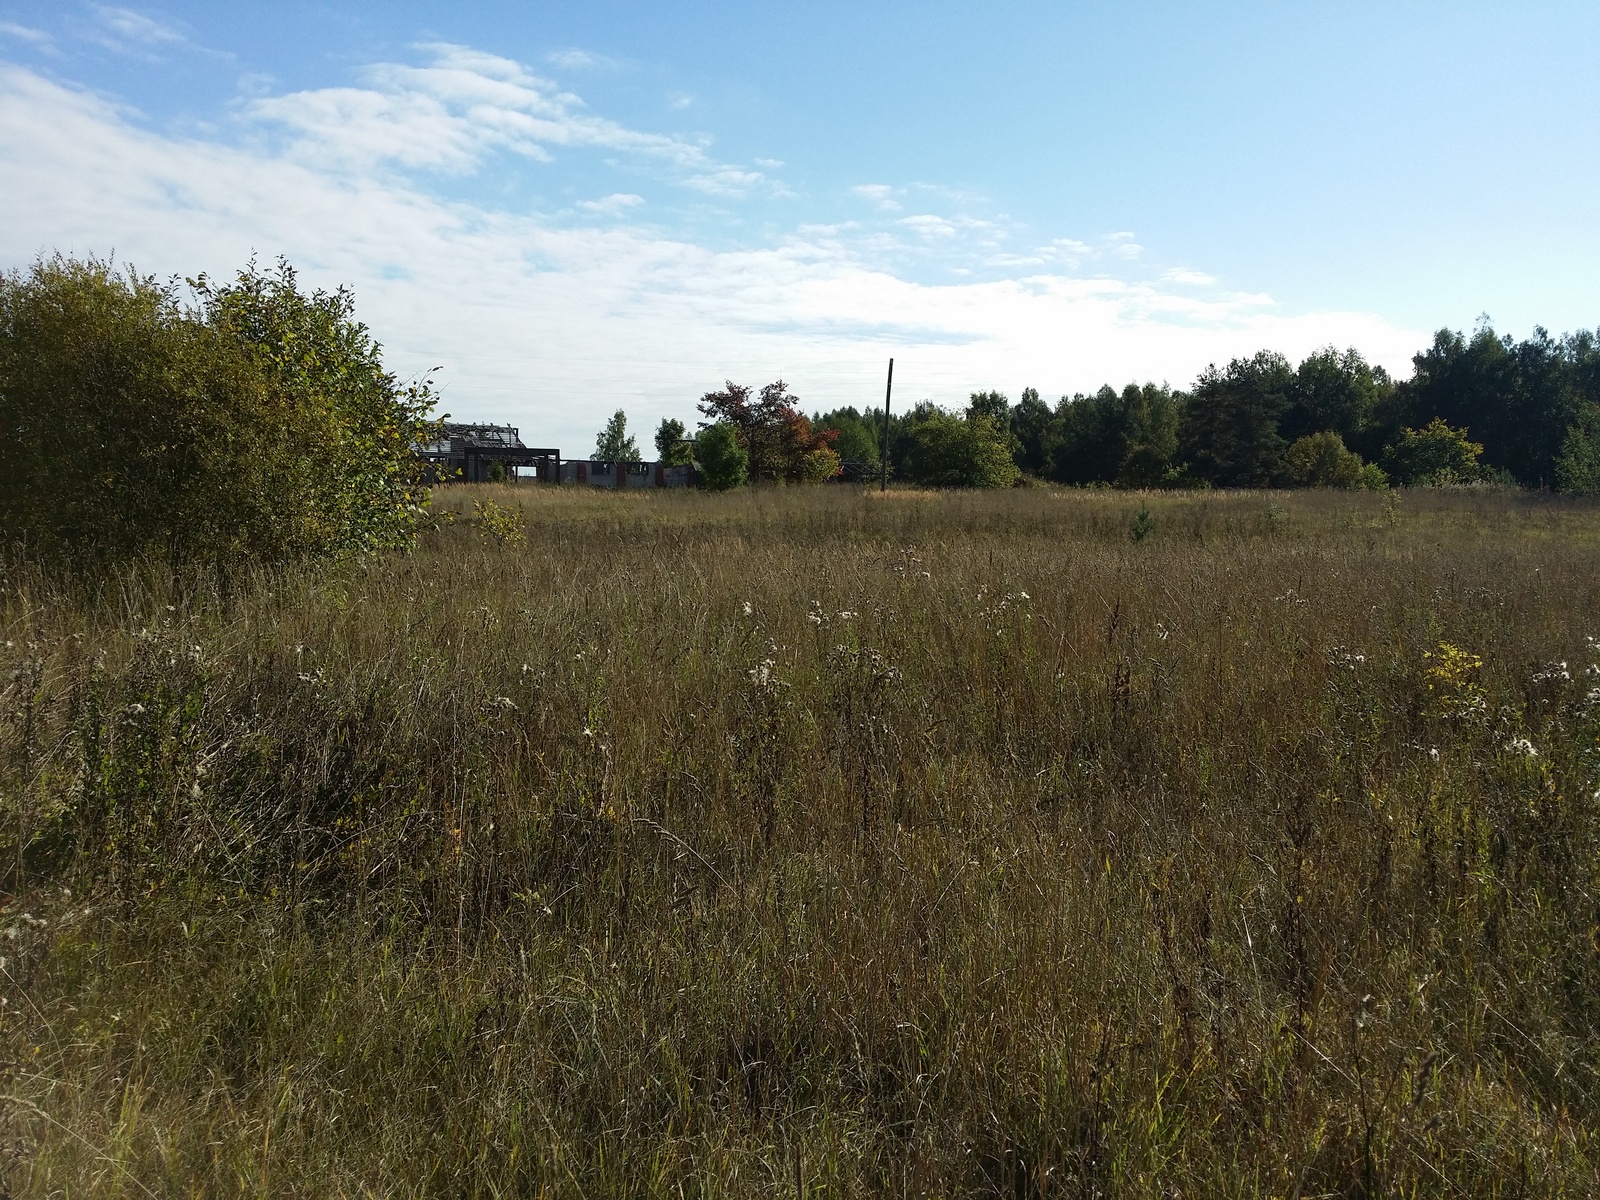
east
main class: Grassland
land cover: Grassland without tree/shrub cover
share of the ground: > 75 %
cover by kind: herbaceous plants 100 %
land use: Agriculture (excluding fallow land and kitchen gardens)
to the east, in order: Grassland without tree/shrub cover; Tracks; Grass margins; Spontaneously vegetated surfaces; Tracks; Grassland with sparse tree/shrub cover; Artificial constructions in urban areas; Grassland with sparse tree/shrub cover; Spontaneously vegetated surfaces; Fences; Spontaneously vegetated surfaces; Fences; Broadleaved woodland
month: September
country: LV
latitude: 57.1731
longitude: 27.5952
